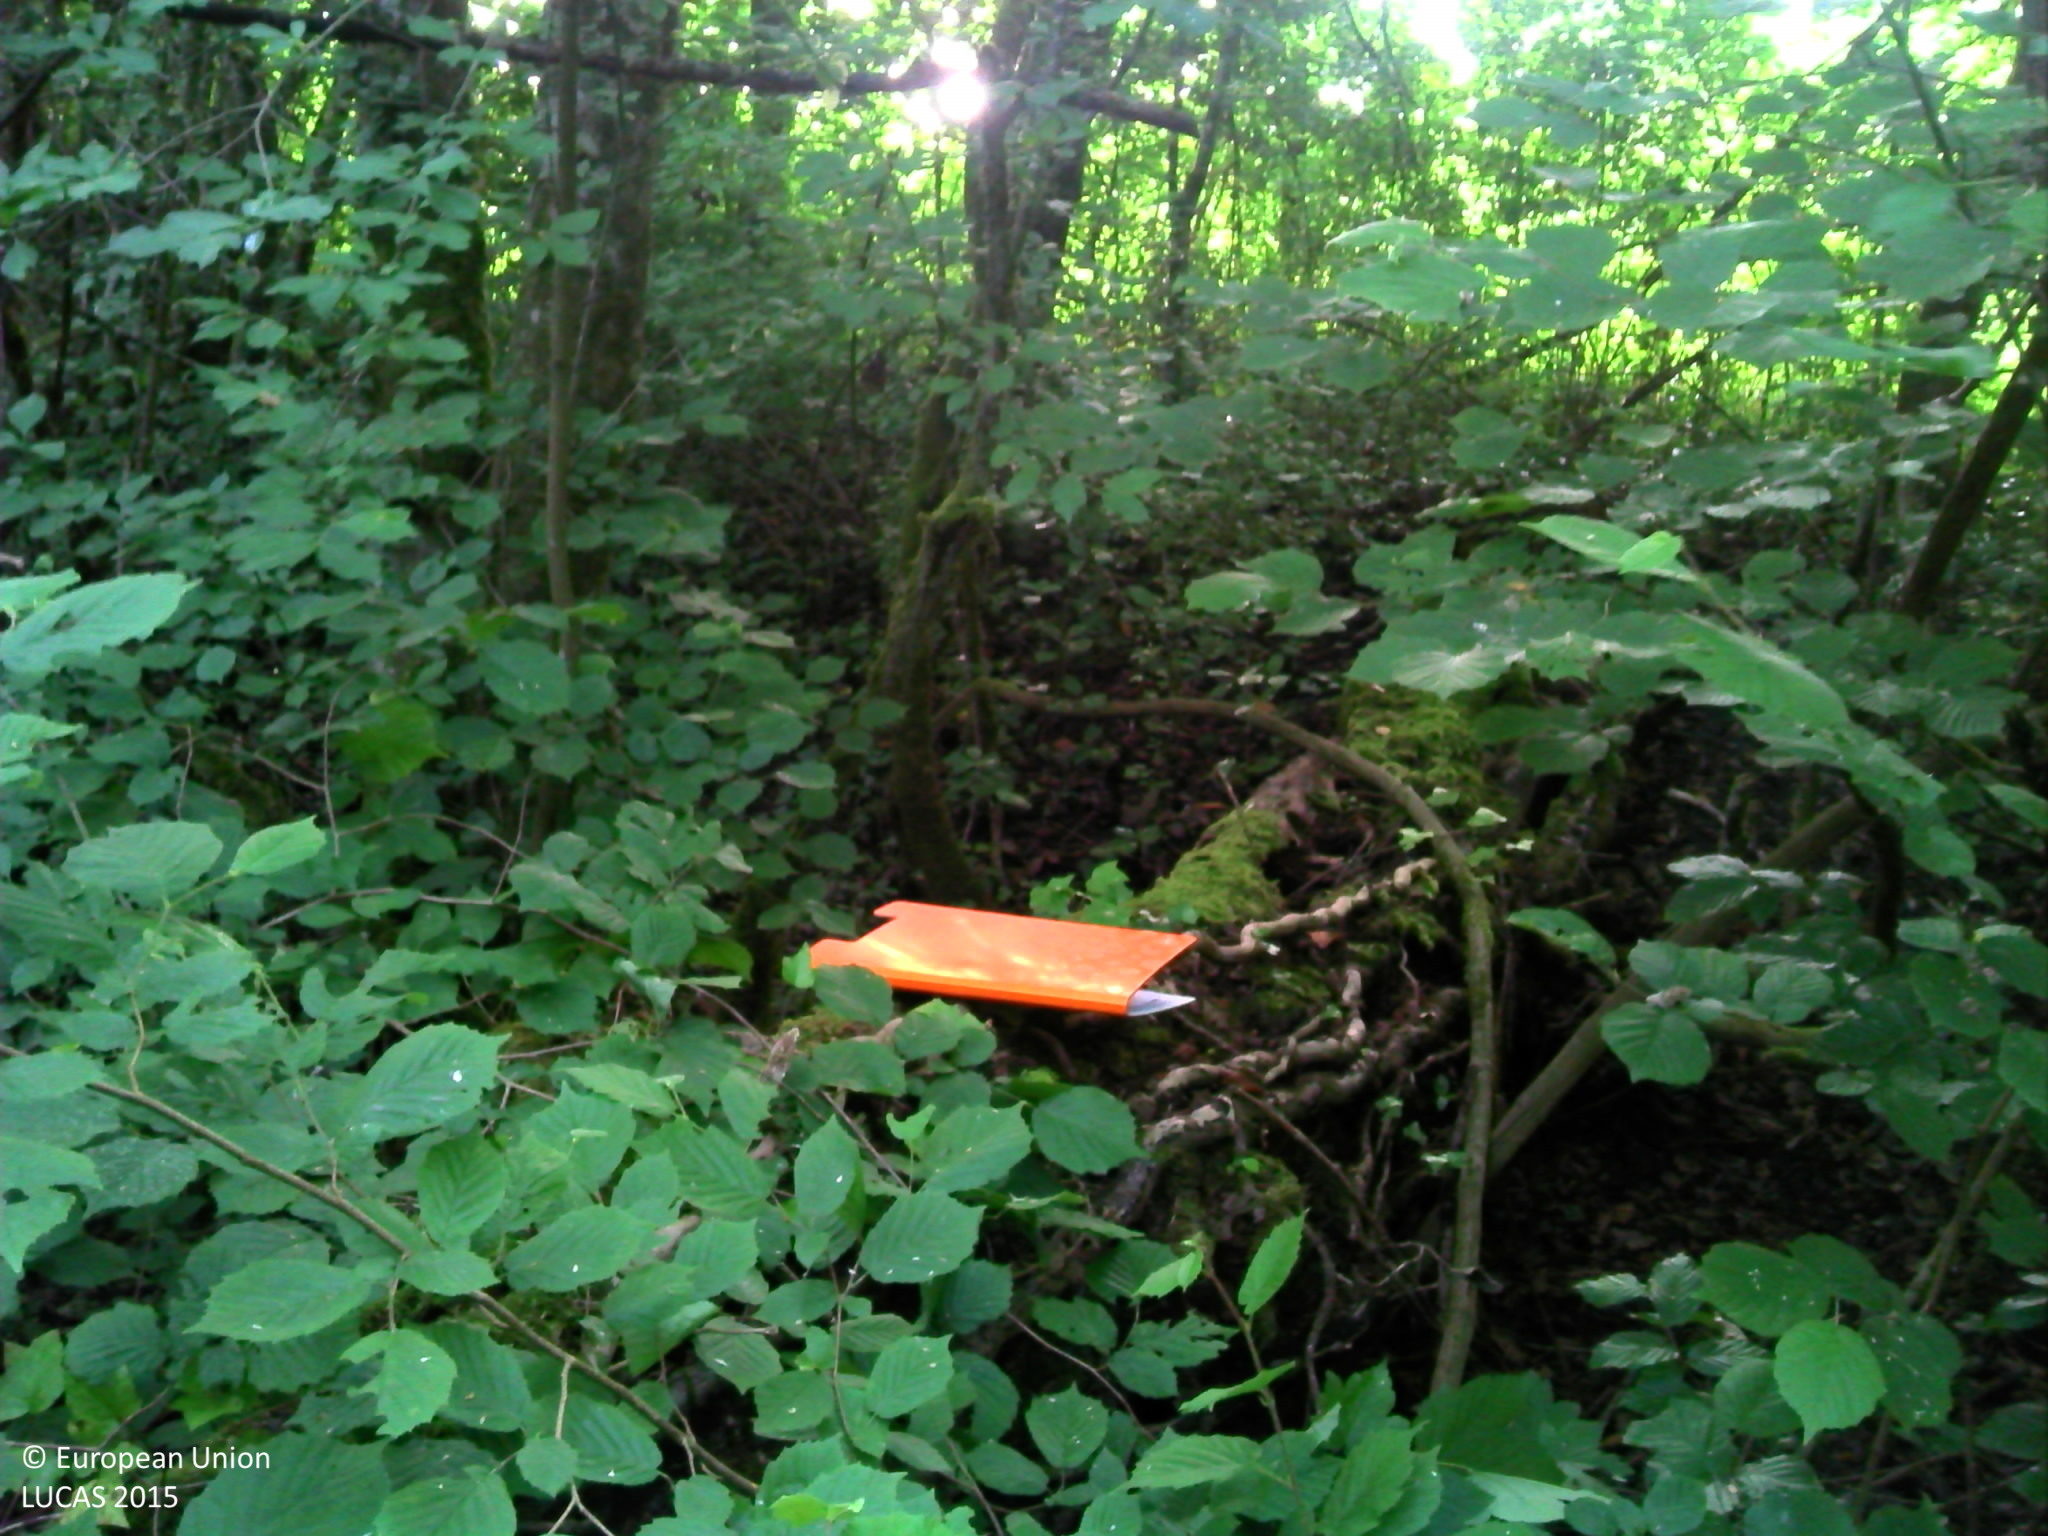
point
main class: Woodland
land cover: Broadleaved woodland
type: beech forest
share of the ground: > 75 %
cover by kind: broadleaved forest trees 90 %, herbaceous plants 10 %
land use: Forestry
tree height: > 5 m
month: June
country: FR
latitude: 47.7428
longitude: 6.1735
